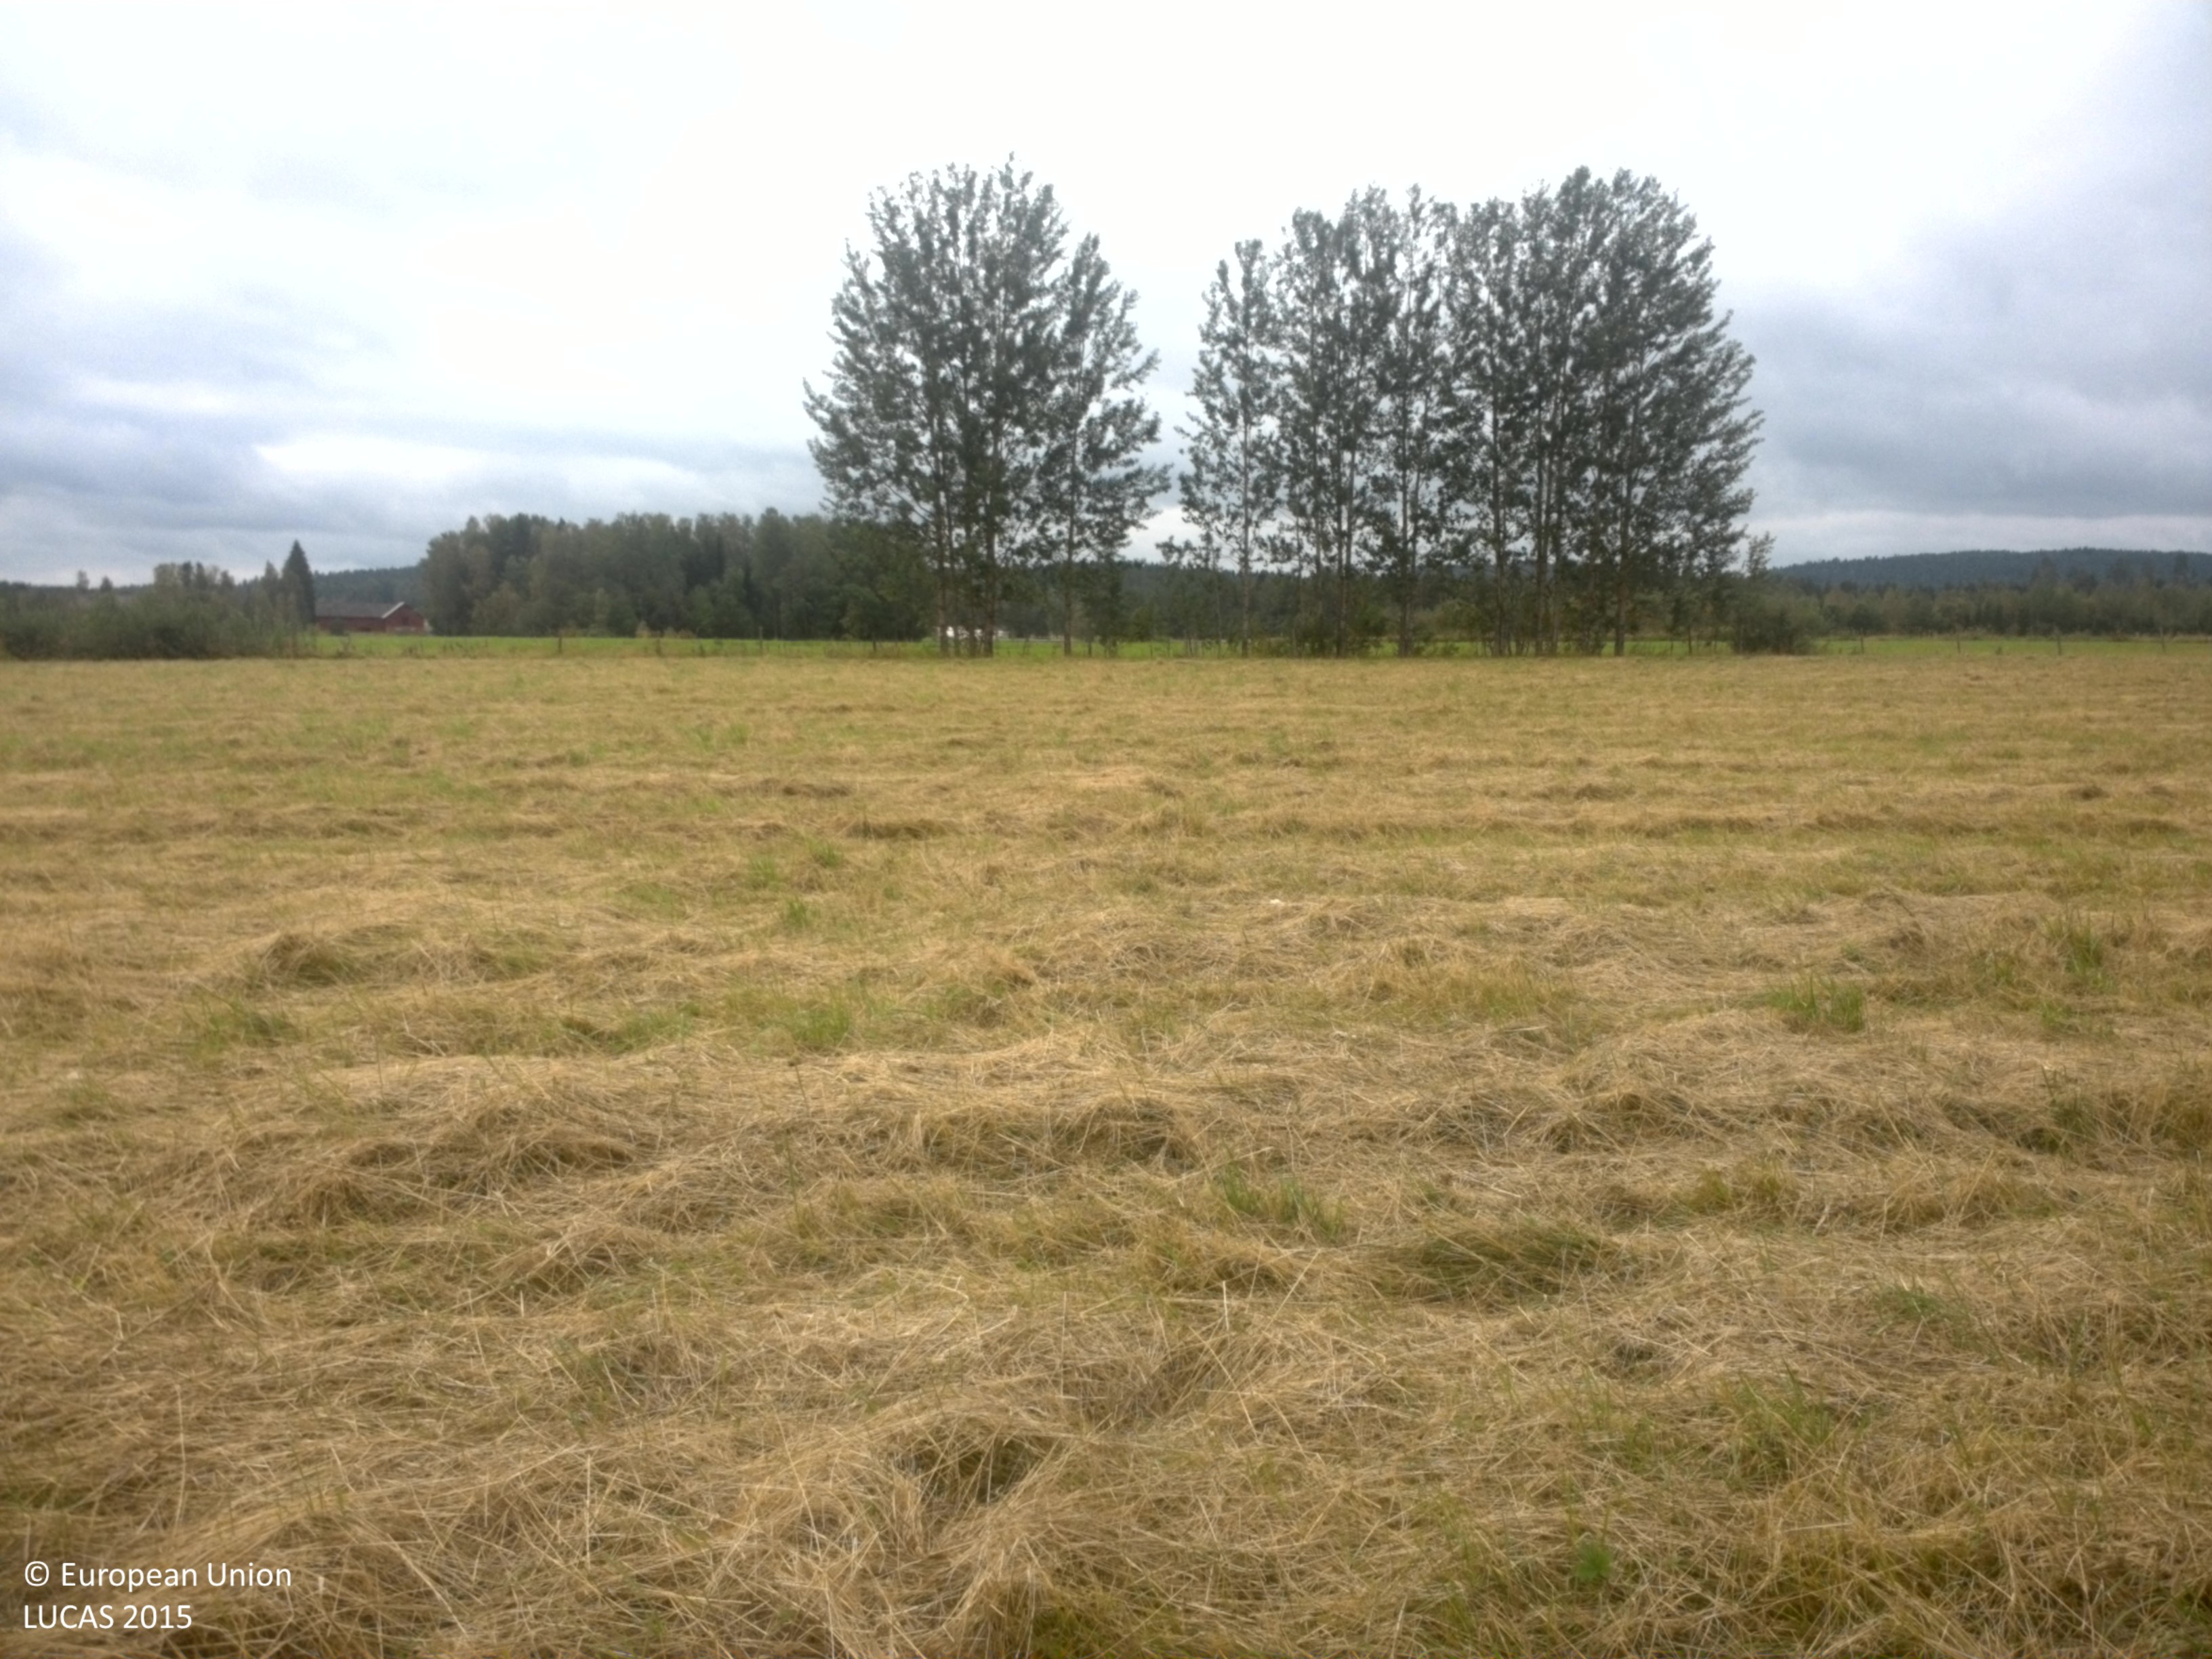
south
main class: Grassland
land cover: Grassland without tree/shrub cover
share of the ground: > 75 %
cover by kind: herbaceous plants 90 %, consolidated bare surface 10 %
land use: Agriculture (excluding fallow land and kitchen gardens)
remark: Harvested field
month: August
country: SE
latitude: 59.6048
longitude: 13.1639
